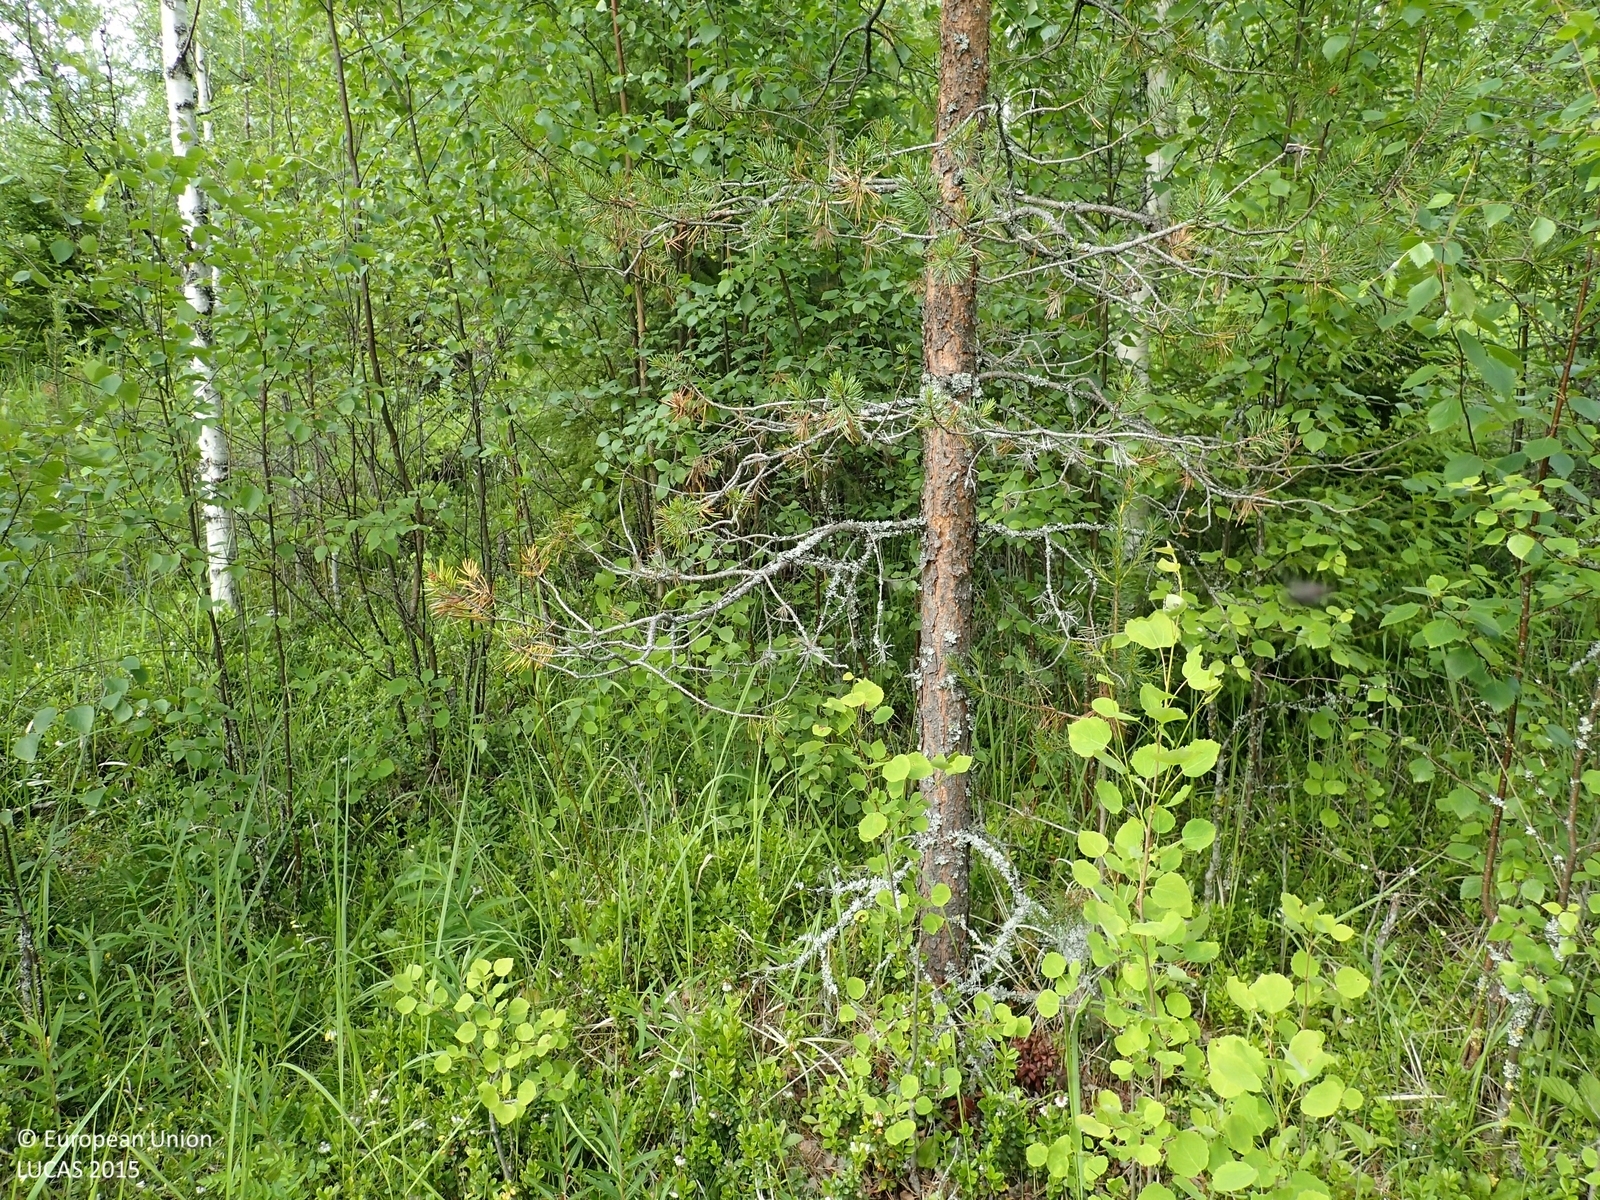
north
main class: Woodland
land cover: Pine dominated mixed woodland
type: boreal forest
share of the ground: 50 - 75 %
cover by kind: broadleaved forest trees 45 %, herbaceous plants 30 %, coniferous forest trees 15 %, shrubs 10 %
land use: Forestry
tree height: < 5 m
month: July
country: FI
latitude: 62.8080
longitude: 21.7540
